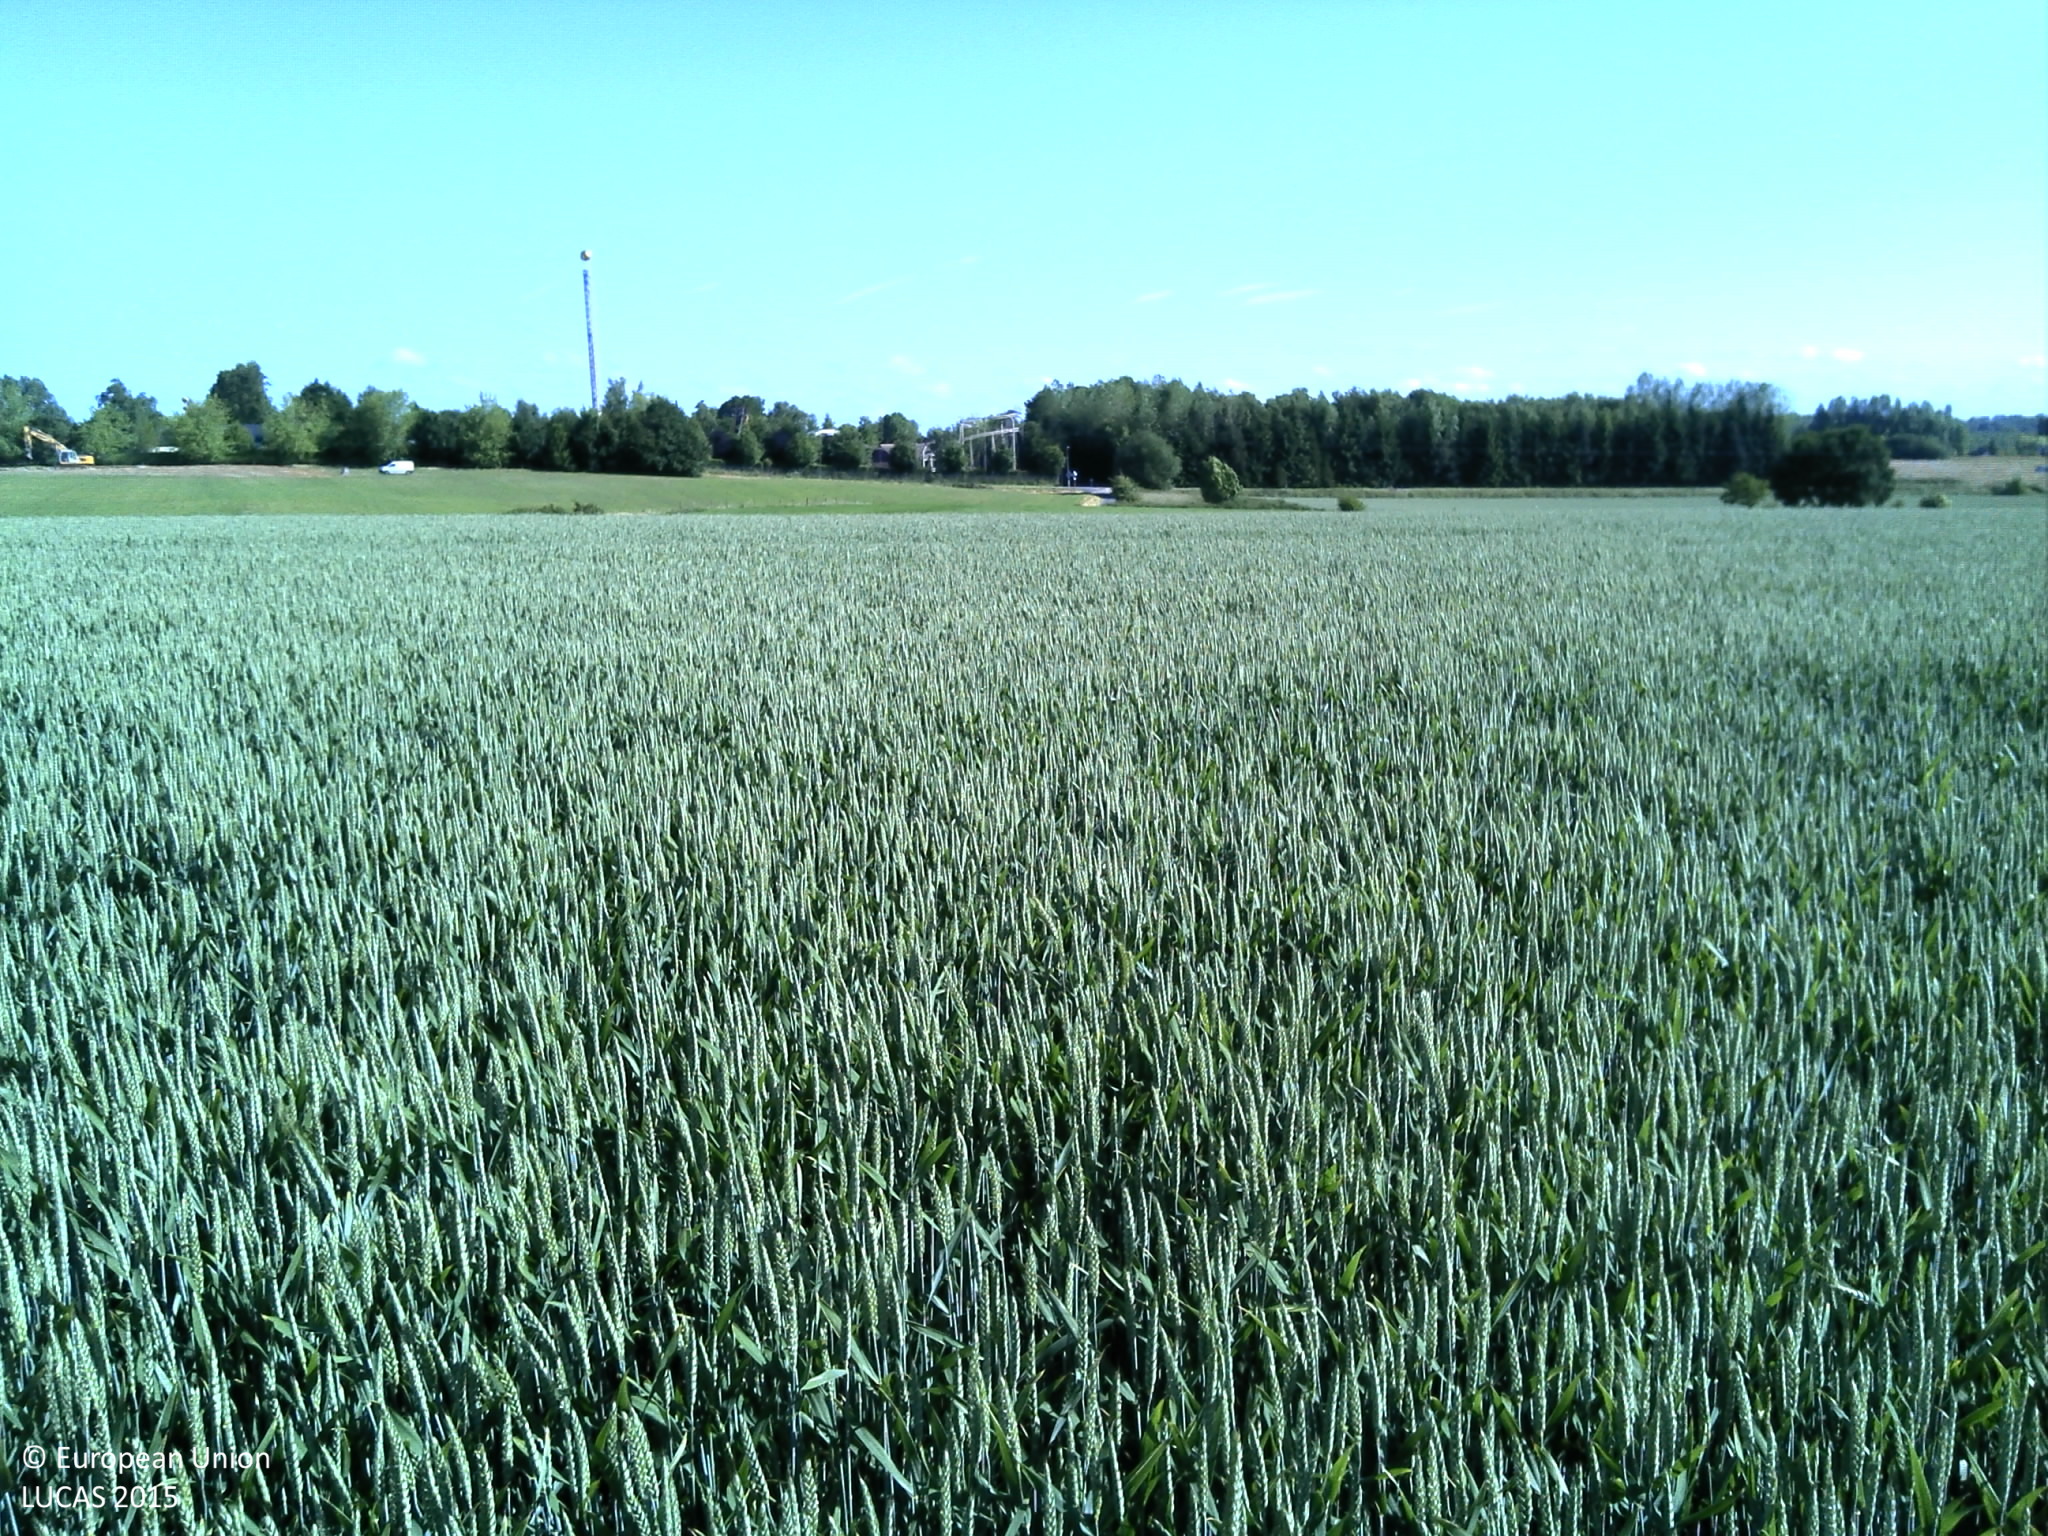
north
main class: Cropland
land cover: Common wheat
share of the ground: > 75 %
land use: Agriculture (excluding fallow land and kitchen gardens)
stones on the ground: < 10 %
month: June
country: FR
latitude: 49.5990
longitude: 1.0817
